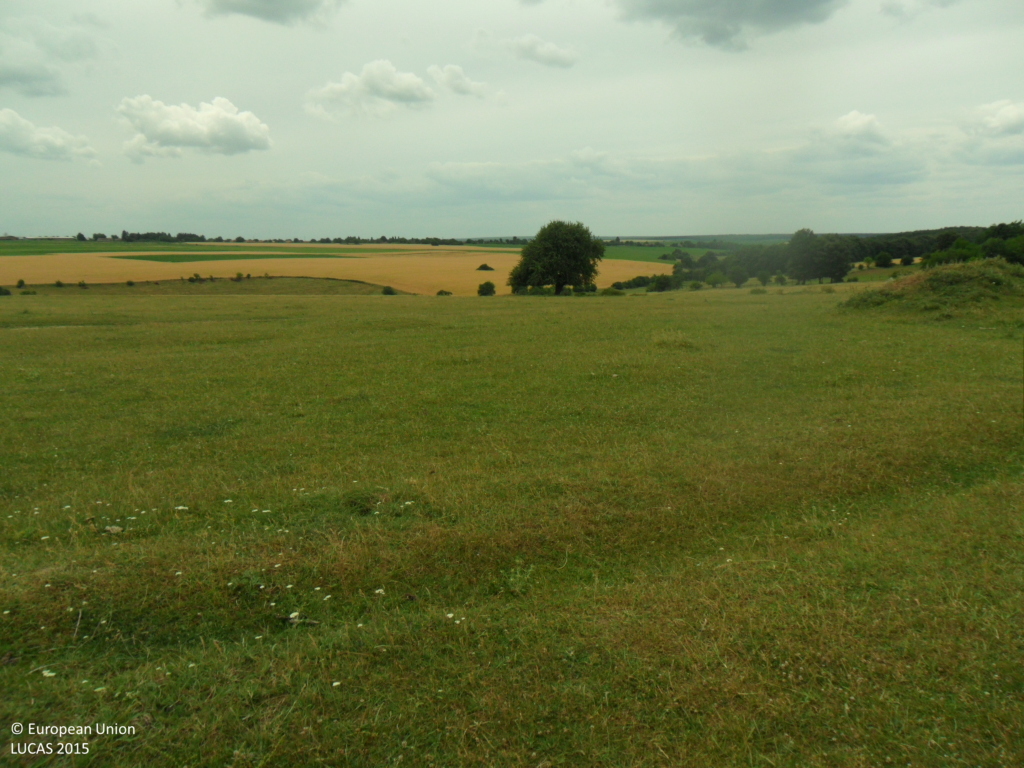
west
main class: Cropland
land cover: Common wheat
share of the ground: > 75 %
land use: Agriculture (excluding fallow land and kitchen gardens)
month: June
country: BG
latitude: 43.6552
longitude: 26.7654
